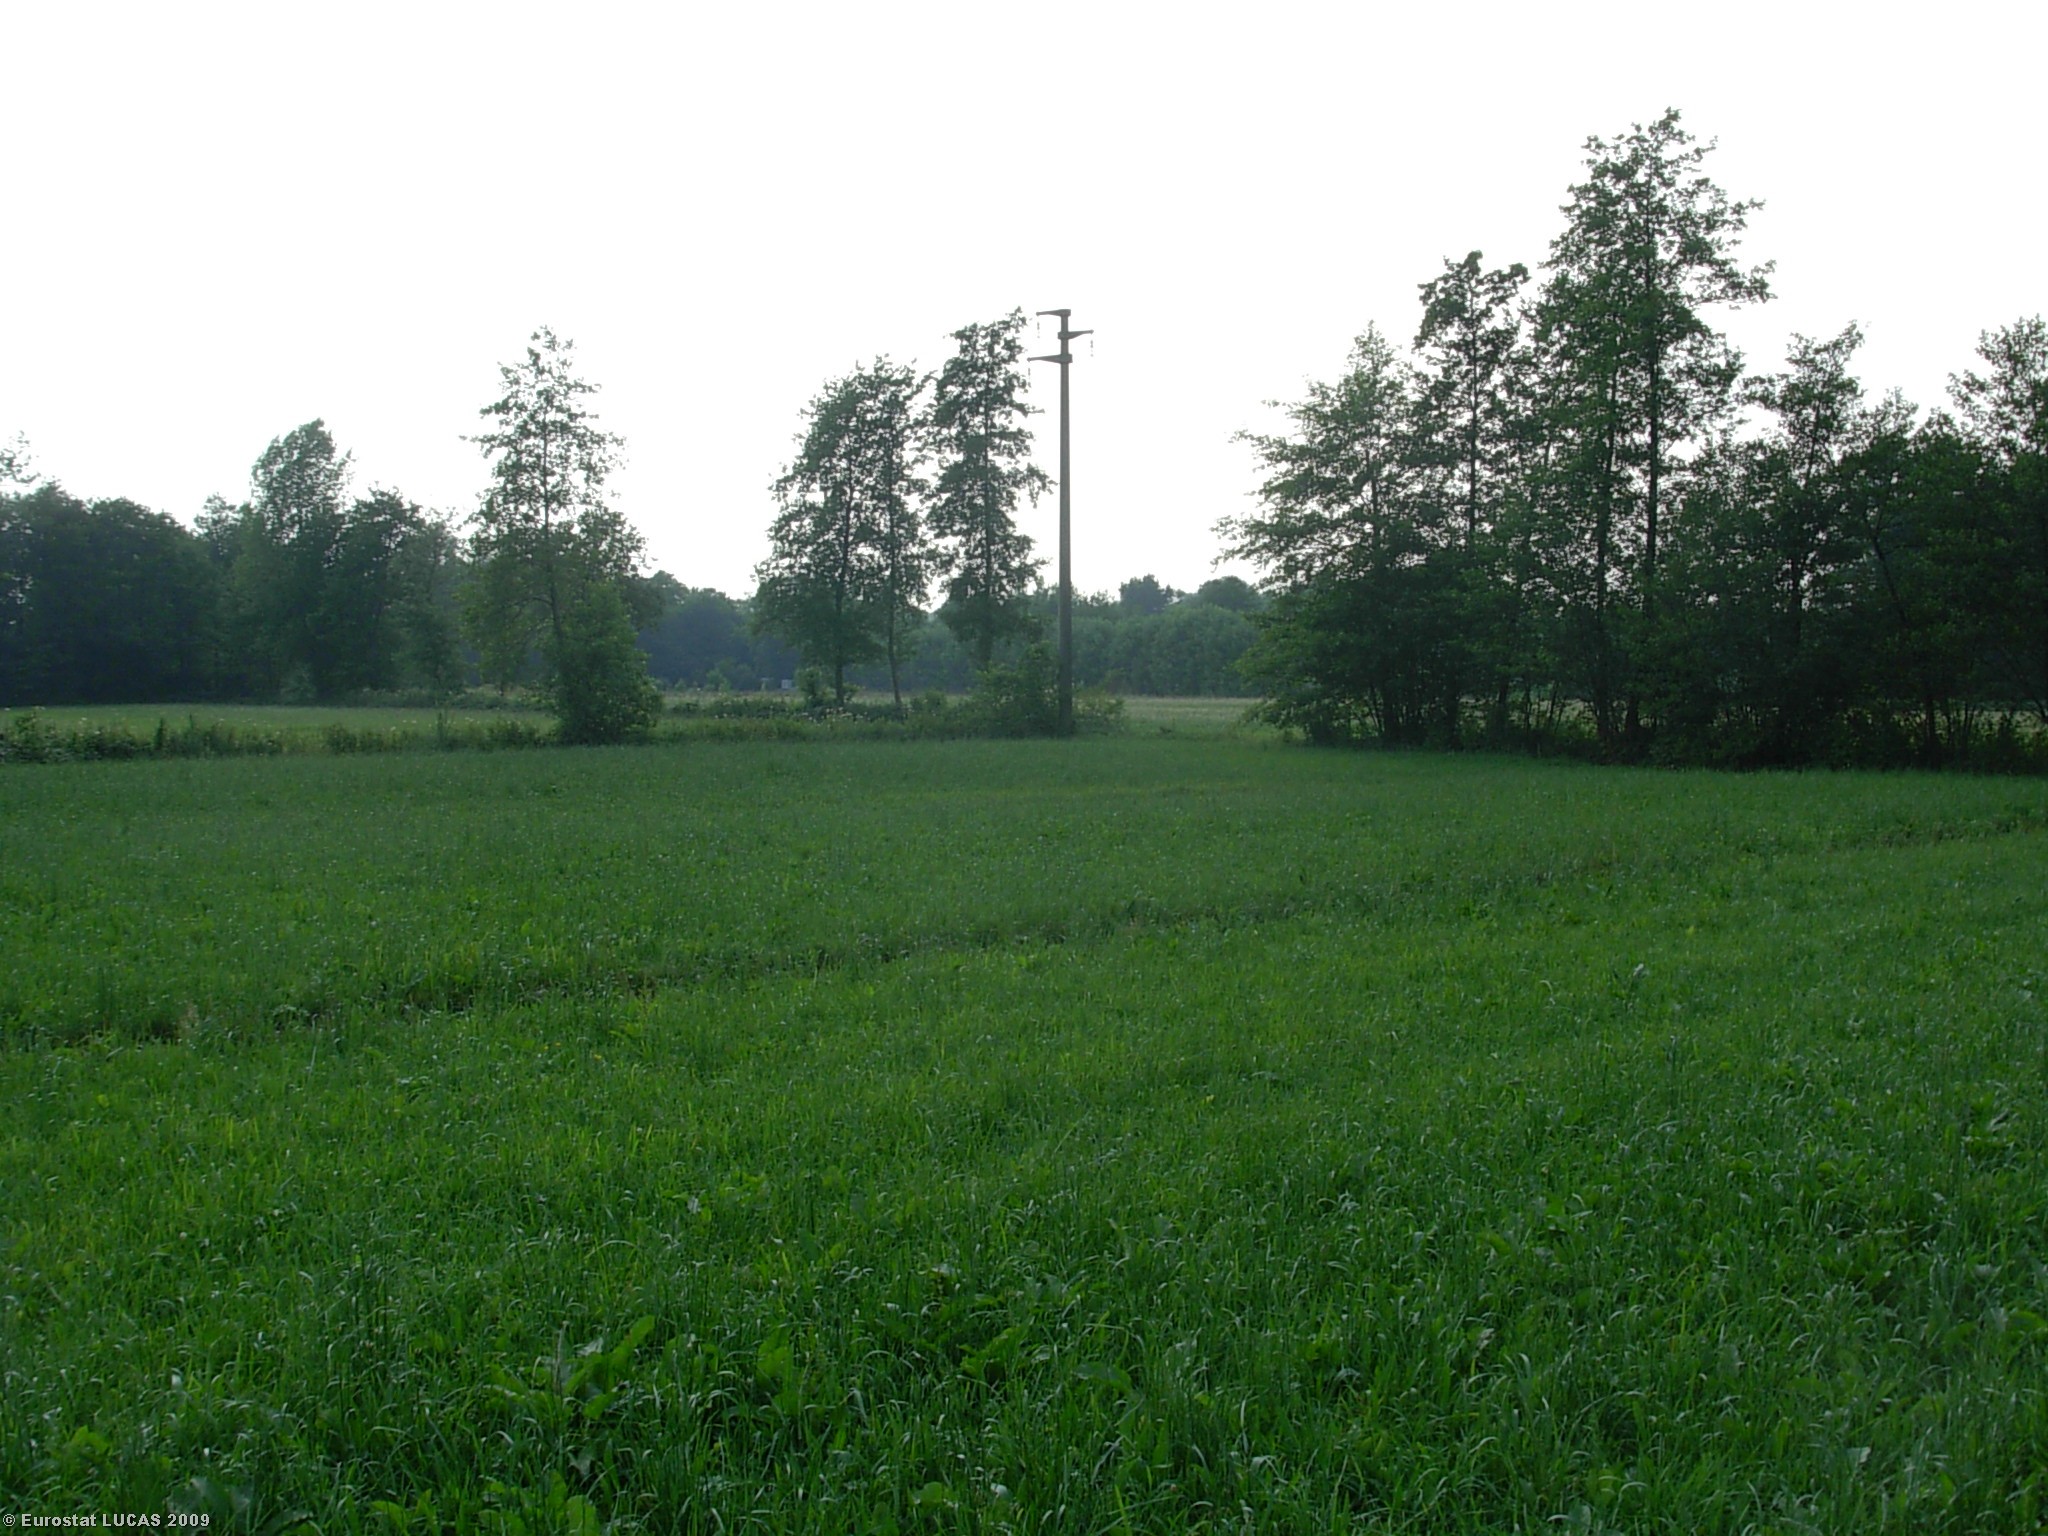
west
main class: Grassland
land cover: Grassland without tree/shrub cover
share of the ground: > 75 %
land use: Agriculture (excluding fallow land and kitchen gardens)
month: June
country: IT
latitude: 45.7183
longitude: 9.2945
